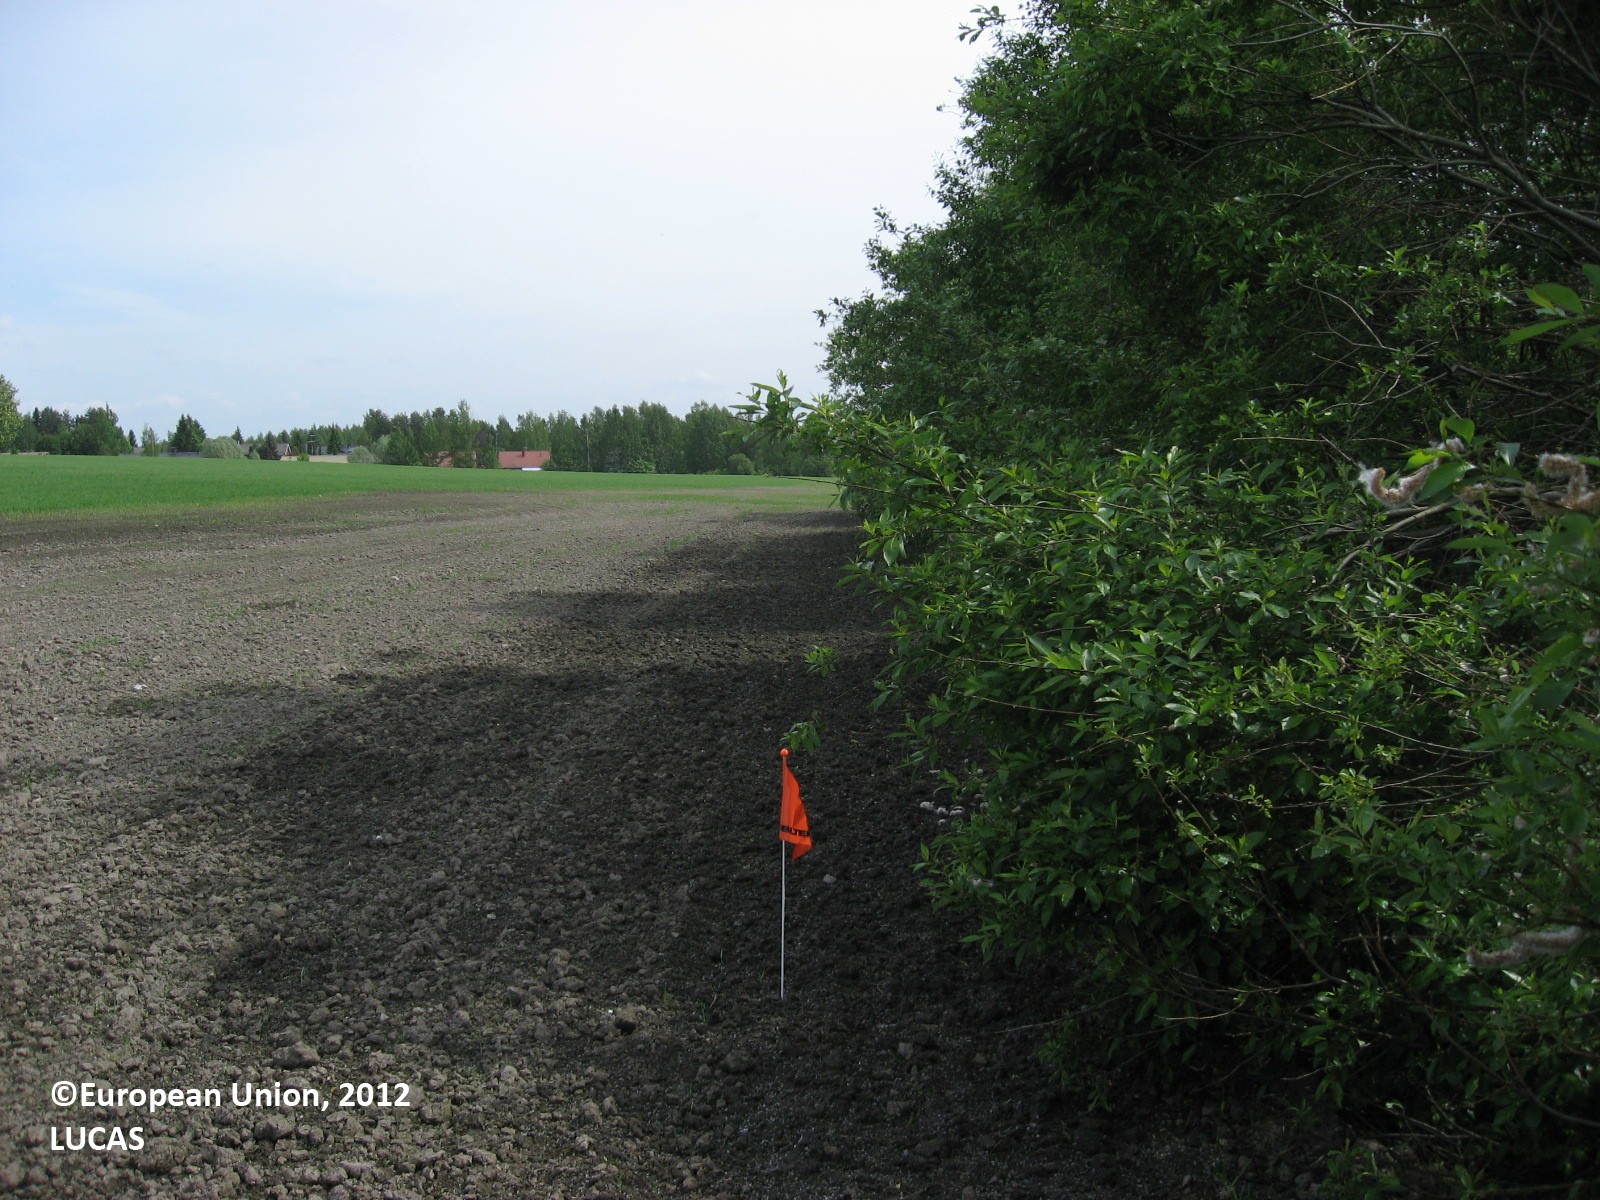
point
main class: Cropland
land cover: Common wheat
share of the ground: < 10 %
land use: Agriculture (excluding fallow land and kitchen gardens)
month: June
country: FI
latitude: 60.3852
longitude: 24.9755
